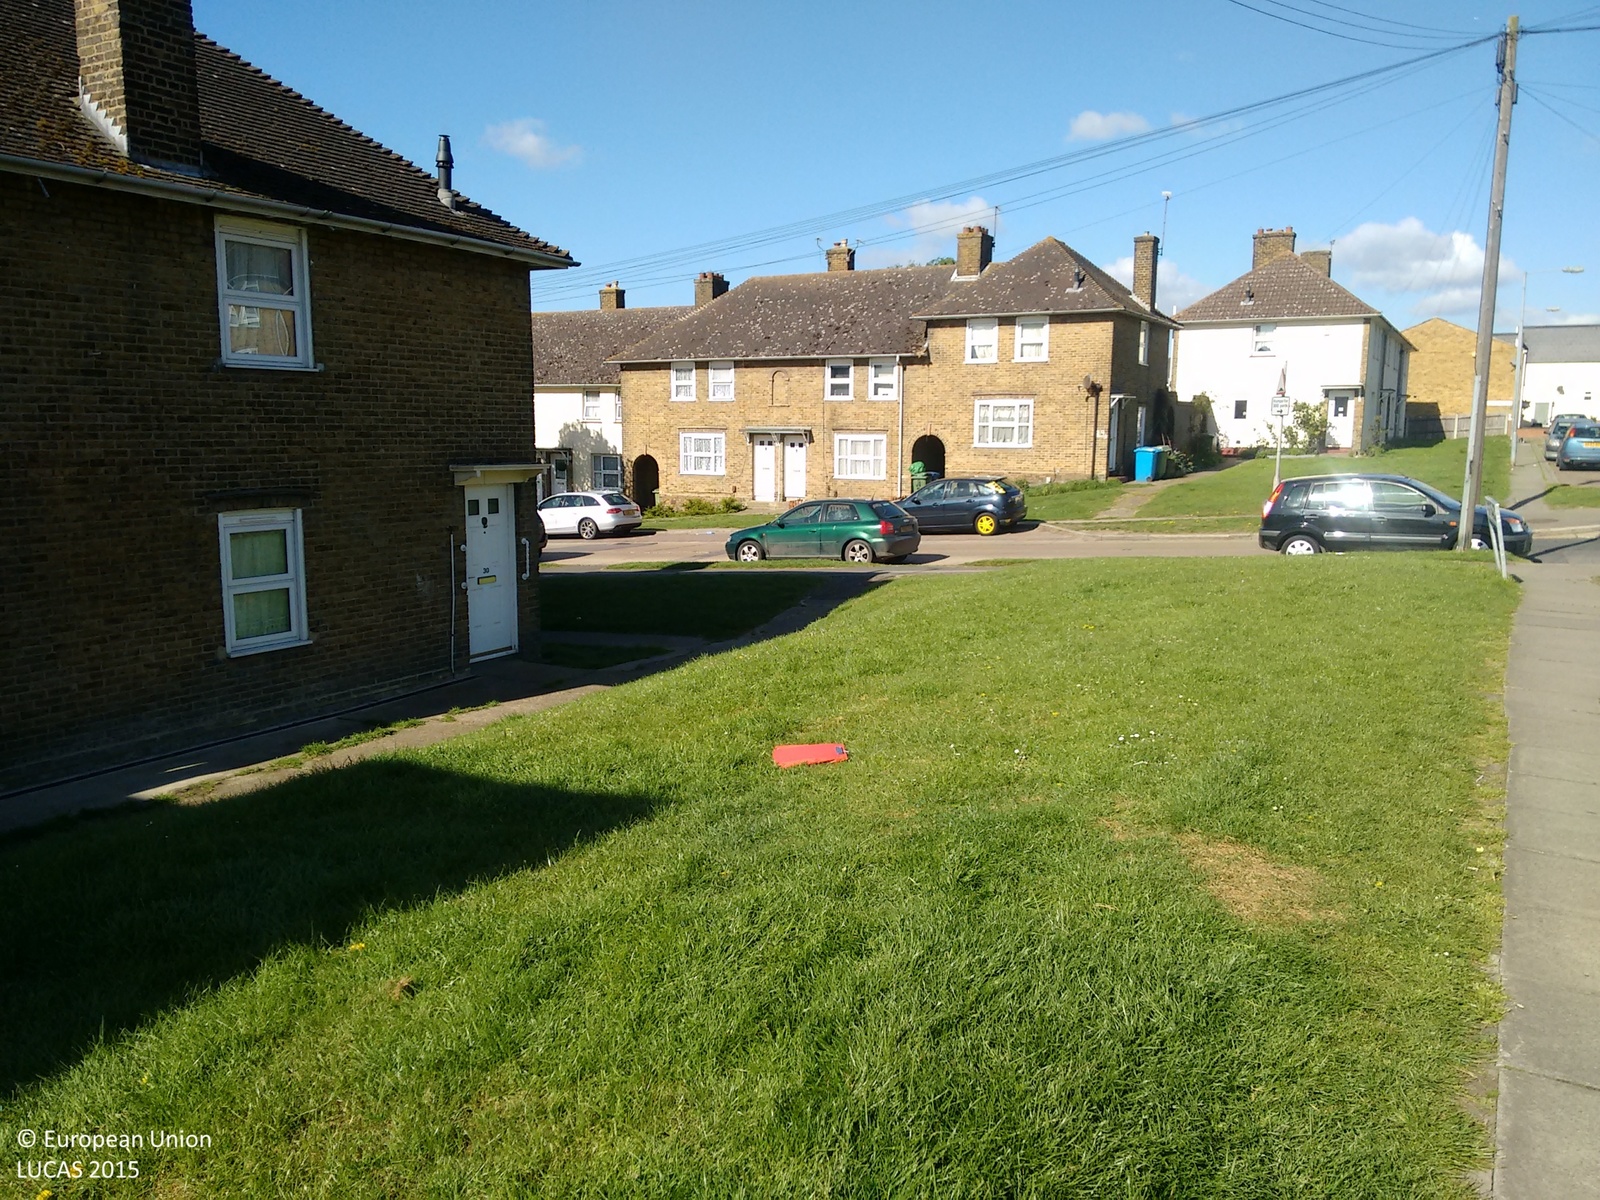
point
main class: Grassland
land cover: Grassland without tree/shrub cover
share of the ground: > 75 %
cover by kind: herbaceous plants 100 %
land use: Residential
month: April
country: GB
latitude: 51.3633
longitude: 0.7393
